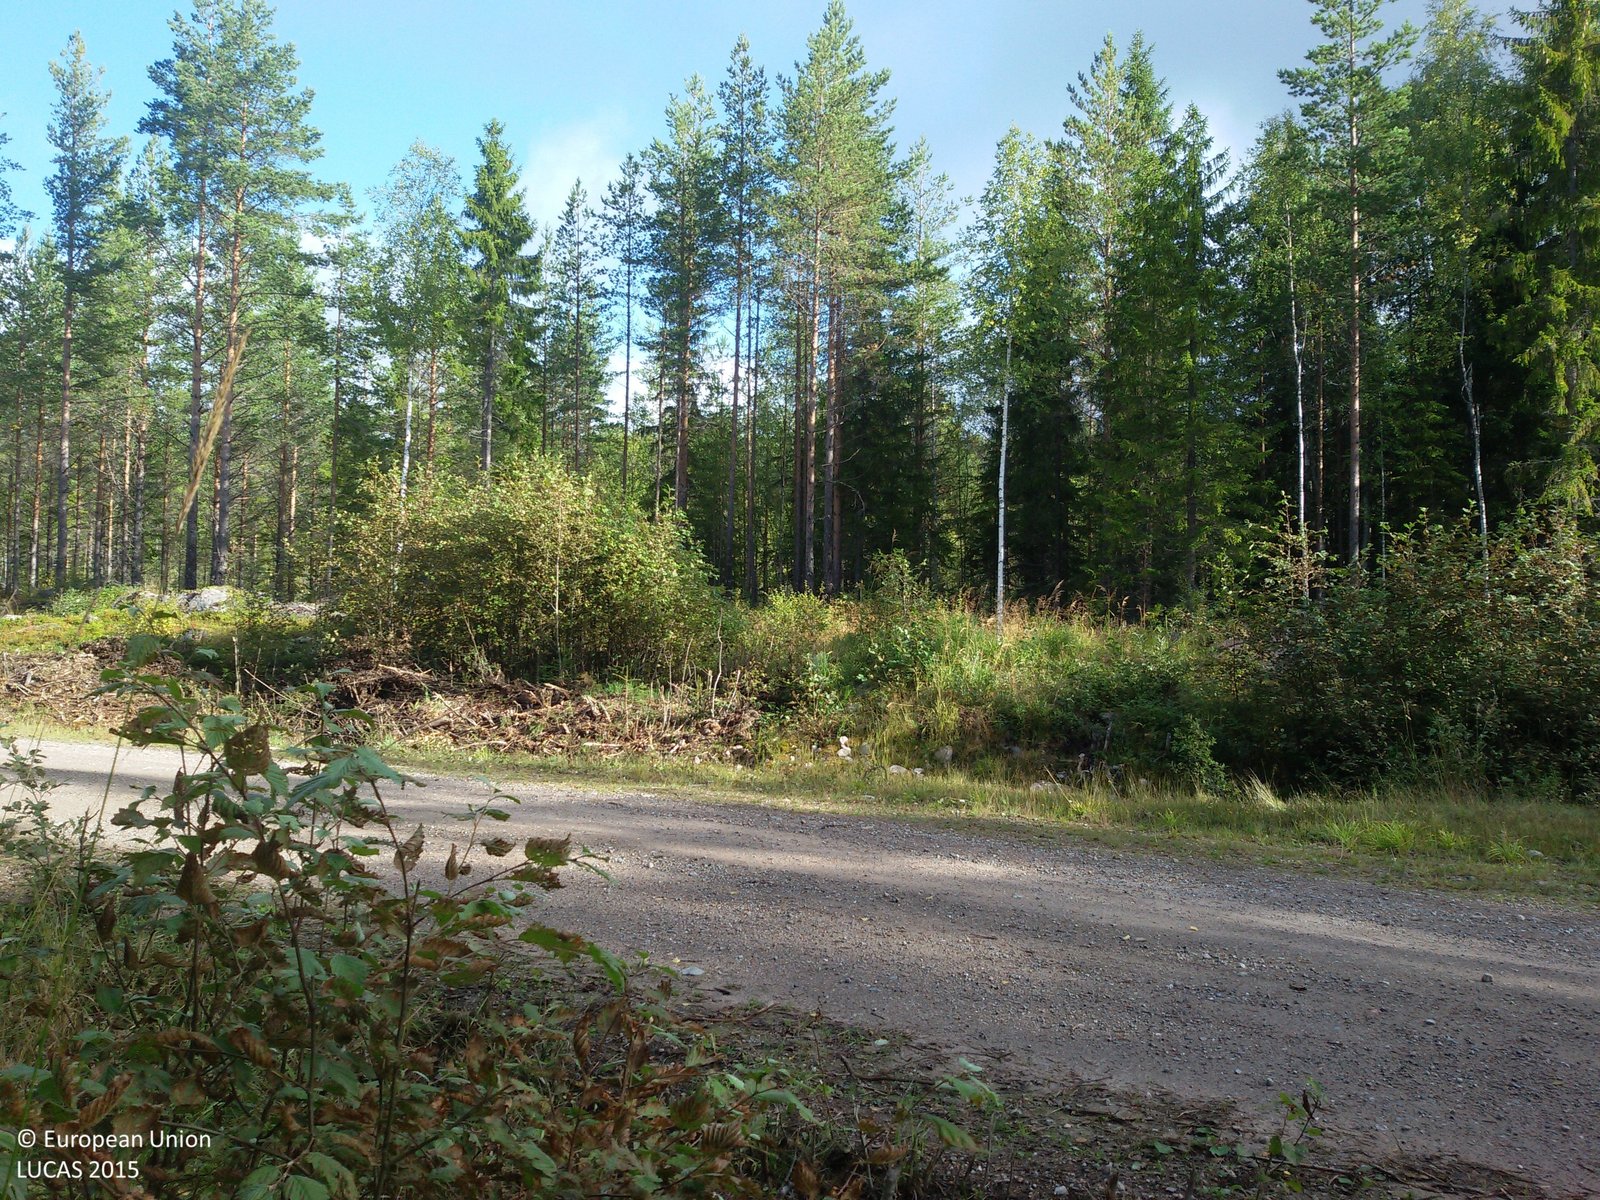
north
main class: Woodland
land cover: Spruce dominated mixed woodland
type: boreal forest
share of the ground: 50 - 75 %
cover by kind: broadleaved forest trees 40 %, coniferous forest trees 30 %, herbaceous plants 30 %
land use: Forestry
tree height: > 5 m
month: September
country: SE
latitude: 61.0517
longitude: 15.4123
